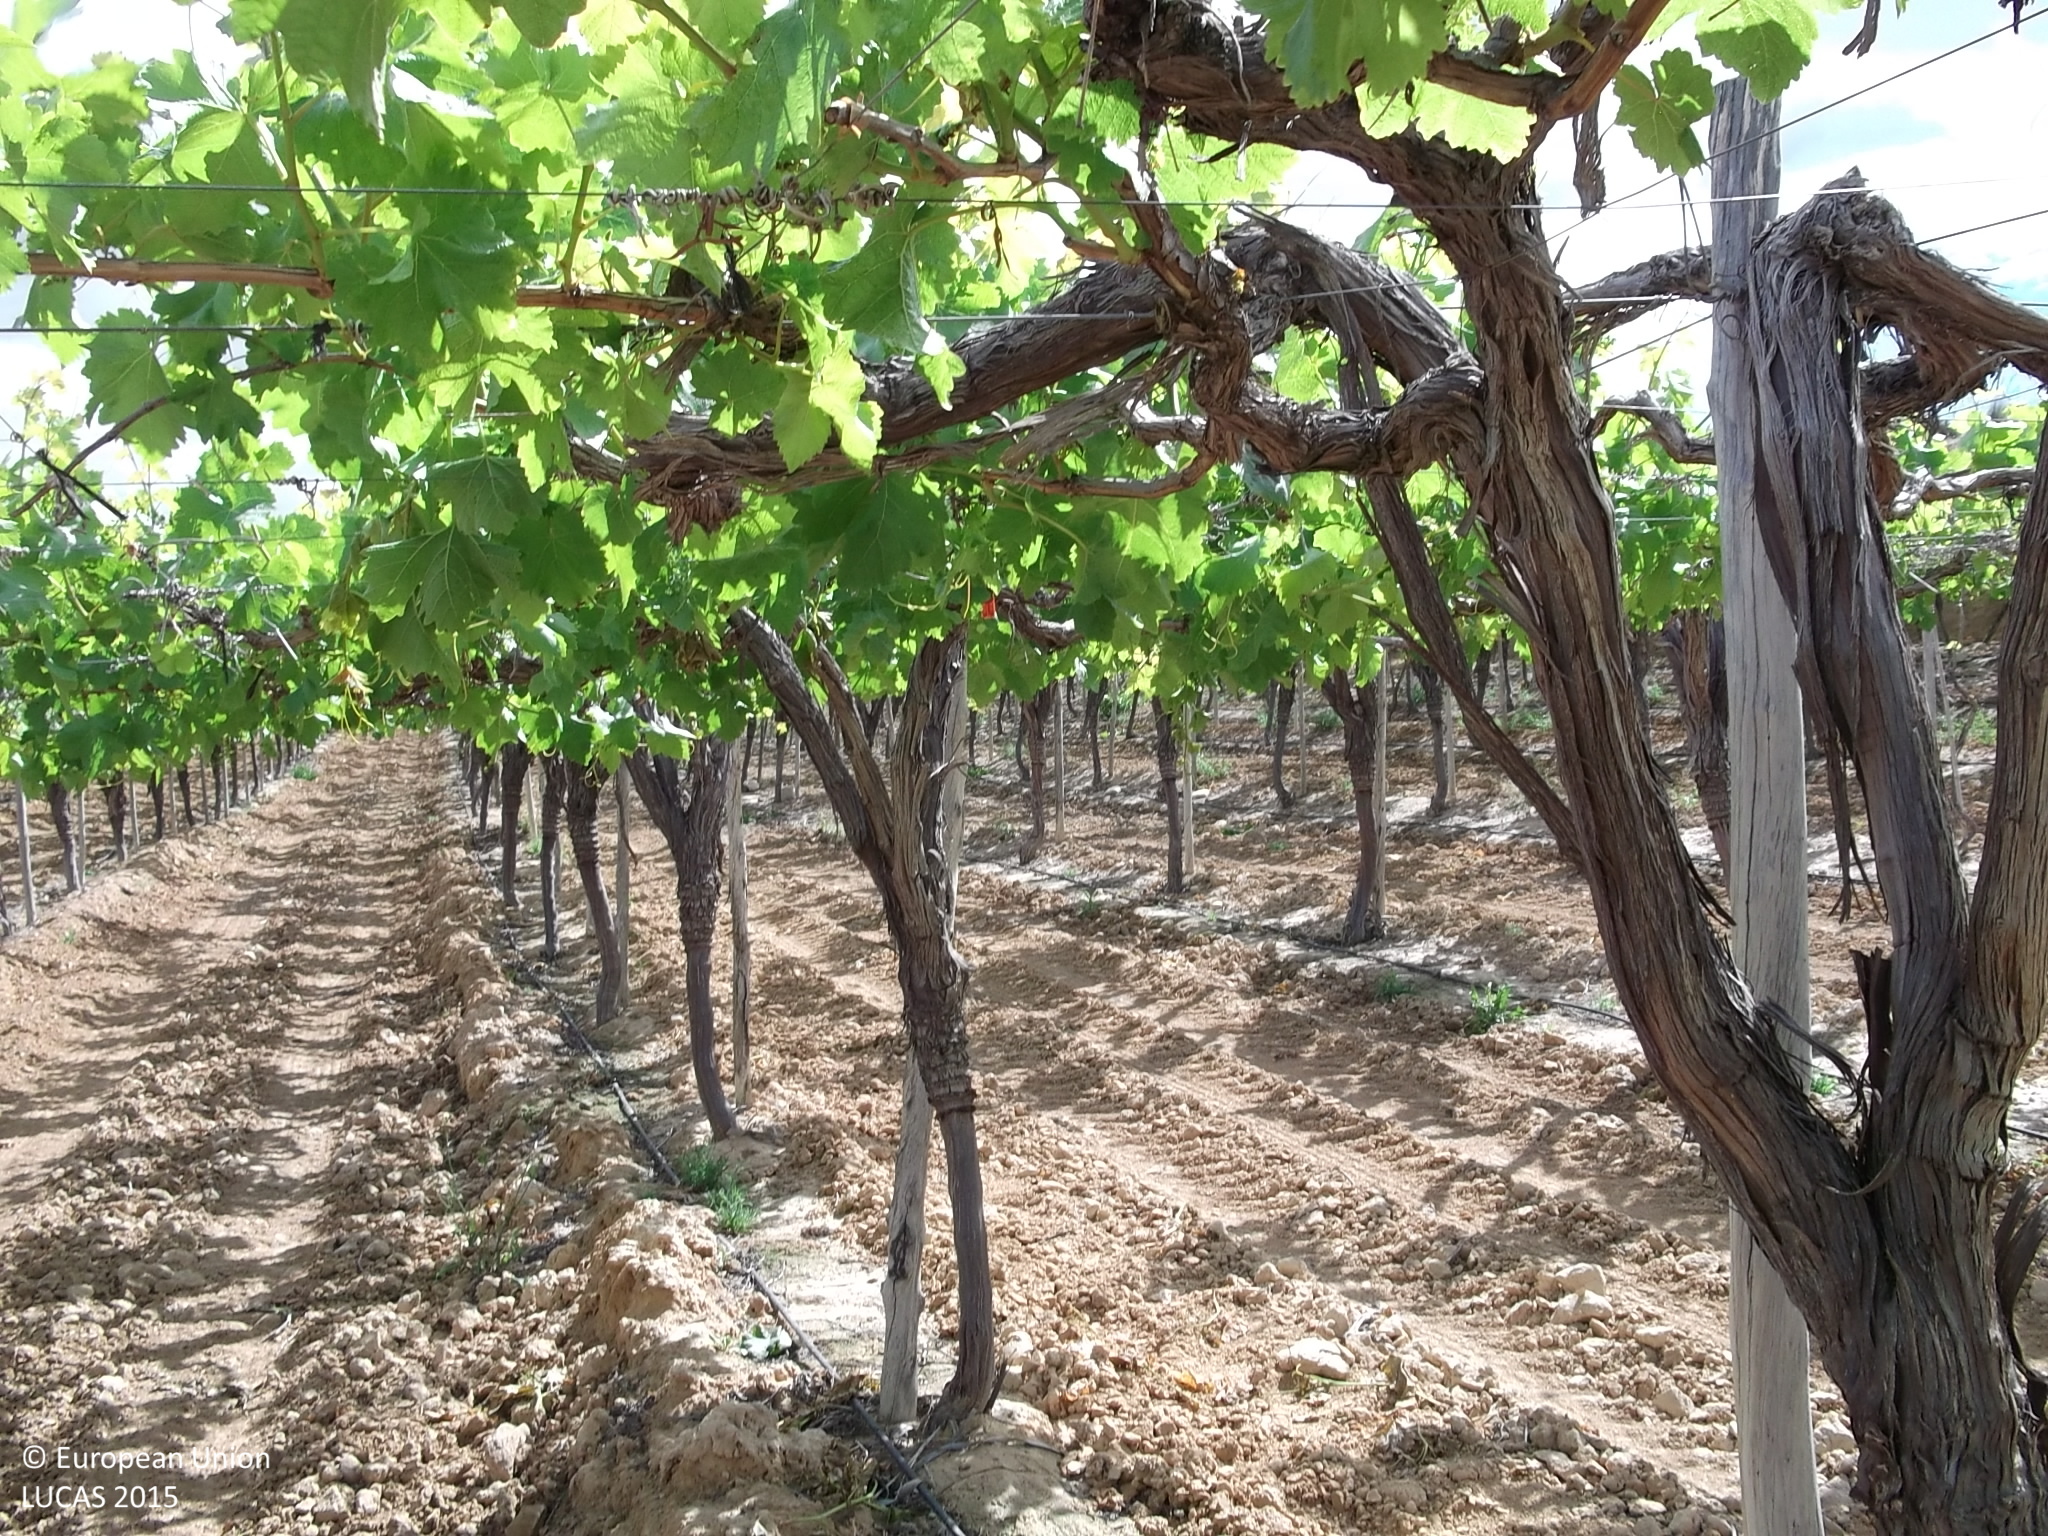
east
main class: Cropland
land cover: Vineyards
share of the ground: > 75 %
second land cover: Other bare soil
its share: > 75 %
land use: Agriculture (excluding fallow land and kitchen gardens)
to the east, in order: Vineyards; Other bare soil; Dry stone walls; Shrubland without tree cover; Tracks; Shrubland without tree cover
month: April
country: ES
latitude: 38.2742
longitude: -1.3391
